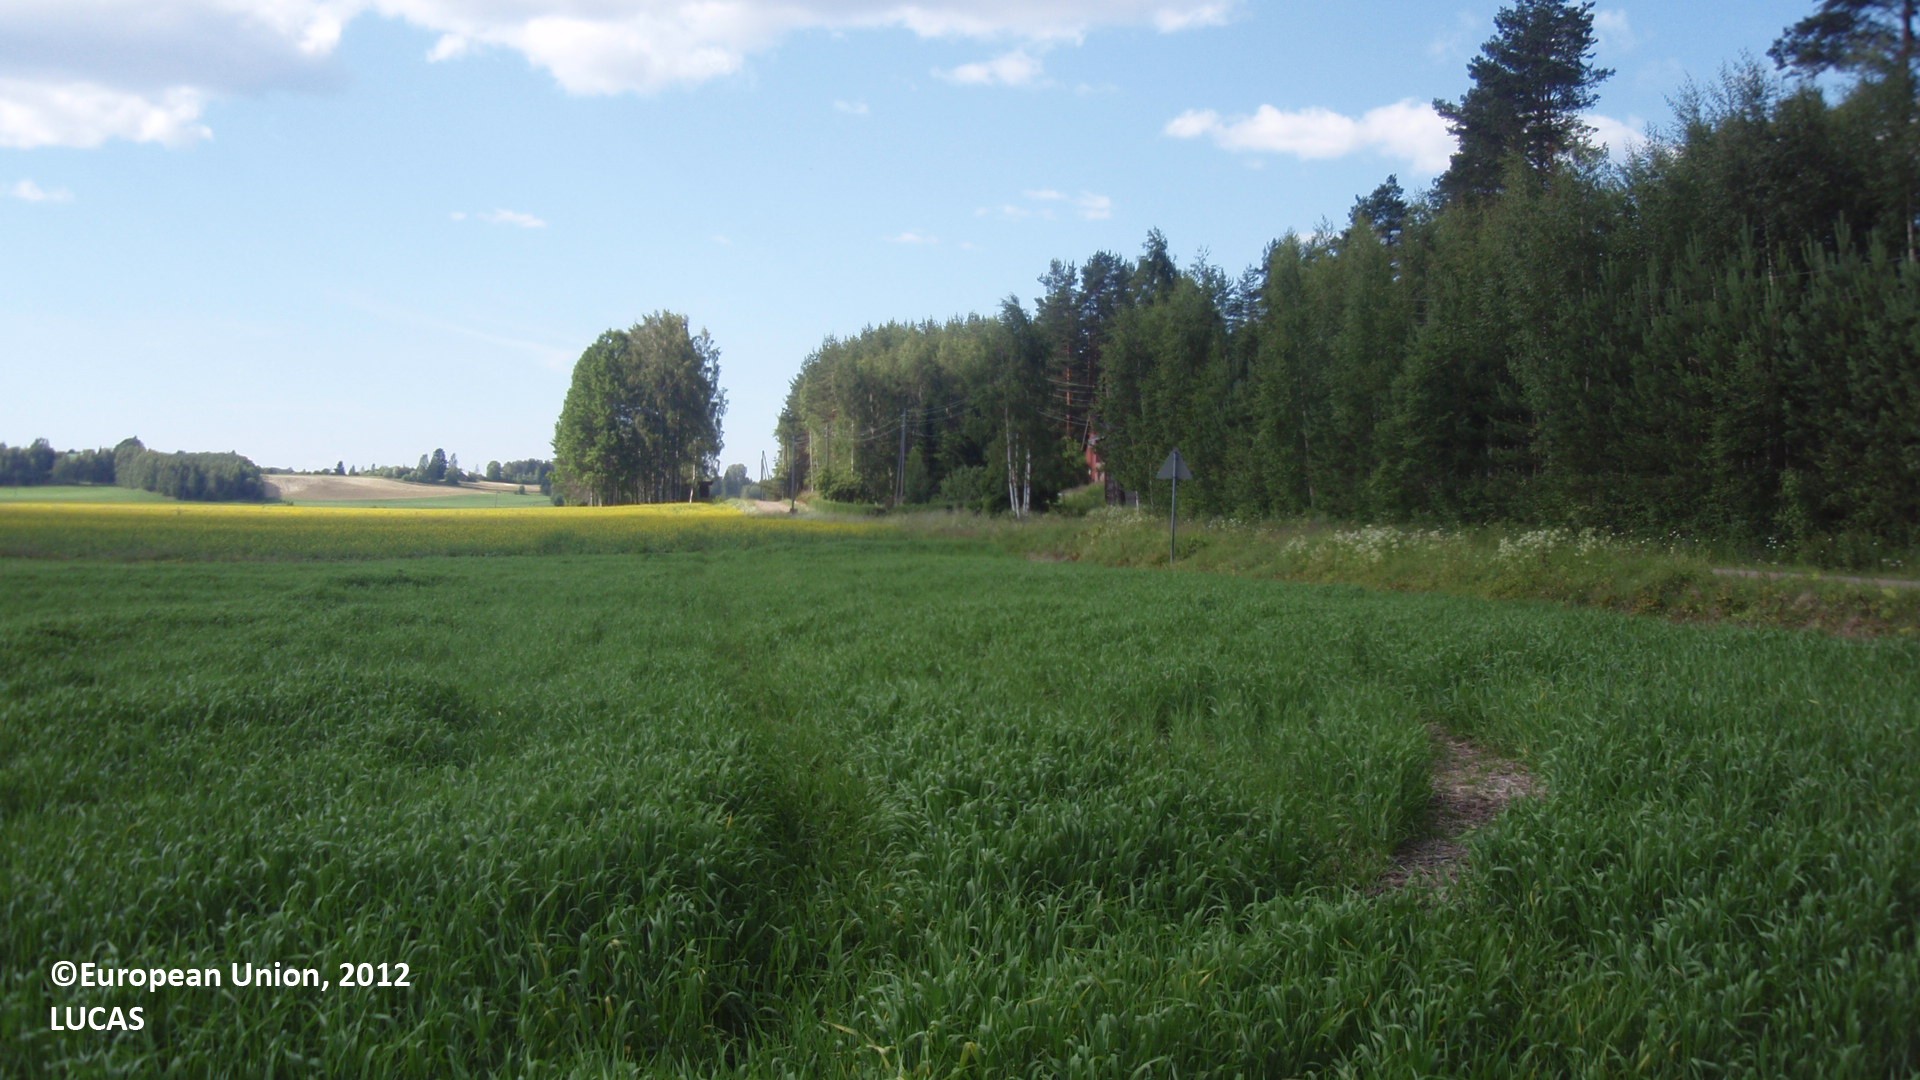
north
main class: Cropland
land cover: Barley
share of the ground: > 75 %
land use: Agriculture (excluding fallow land and kitchen gardens)
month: July
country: FI
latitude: 61.5208
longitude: 29.6381
